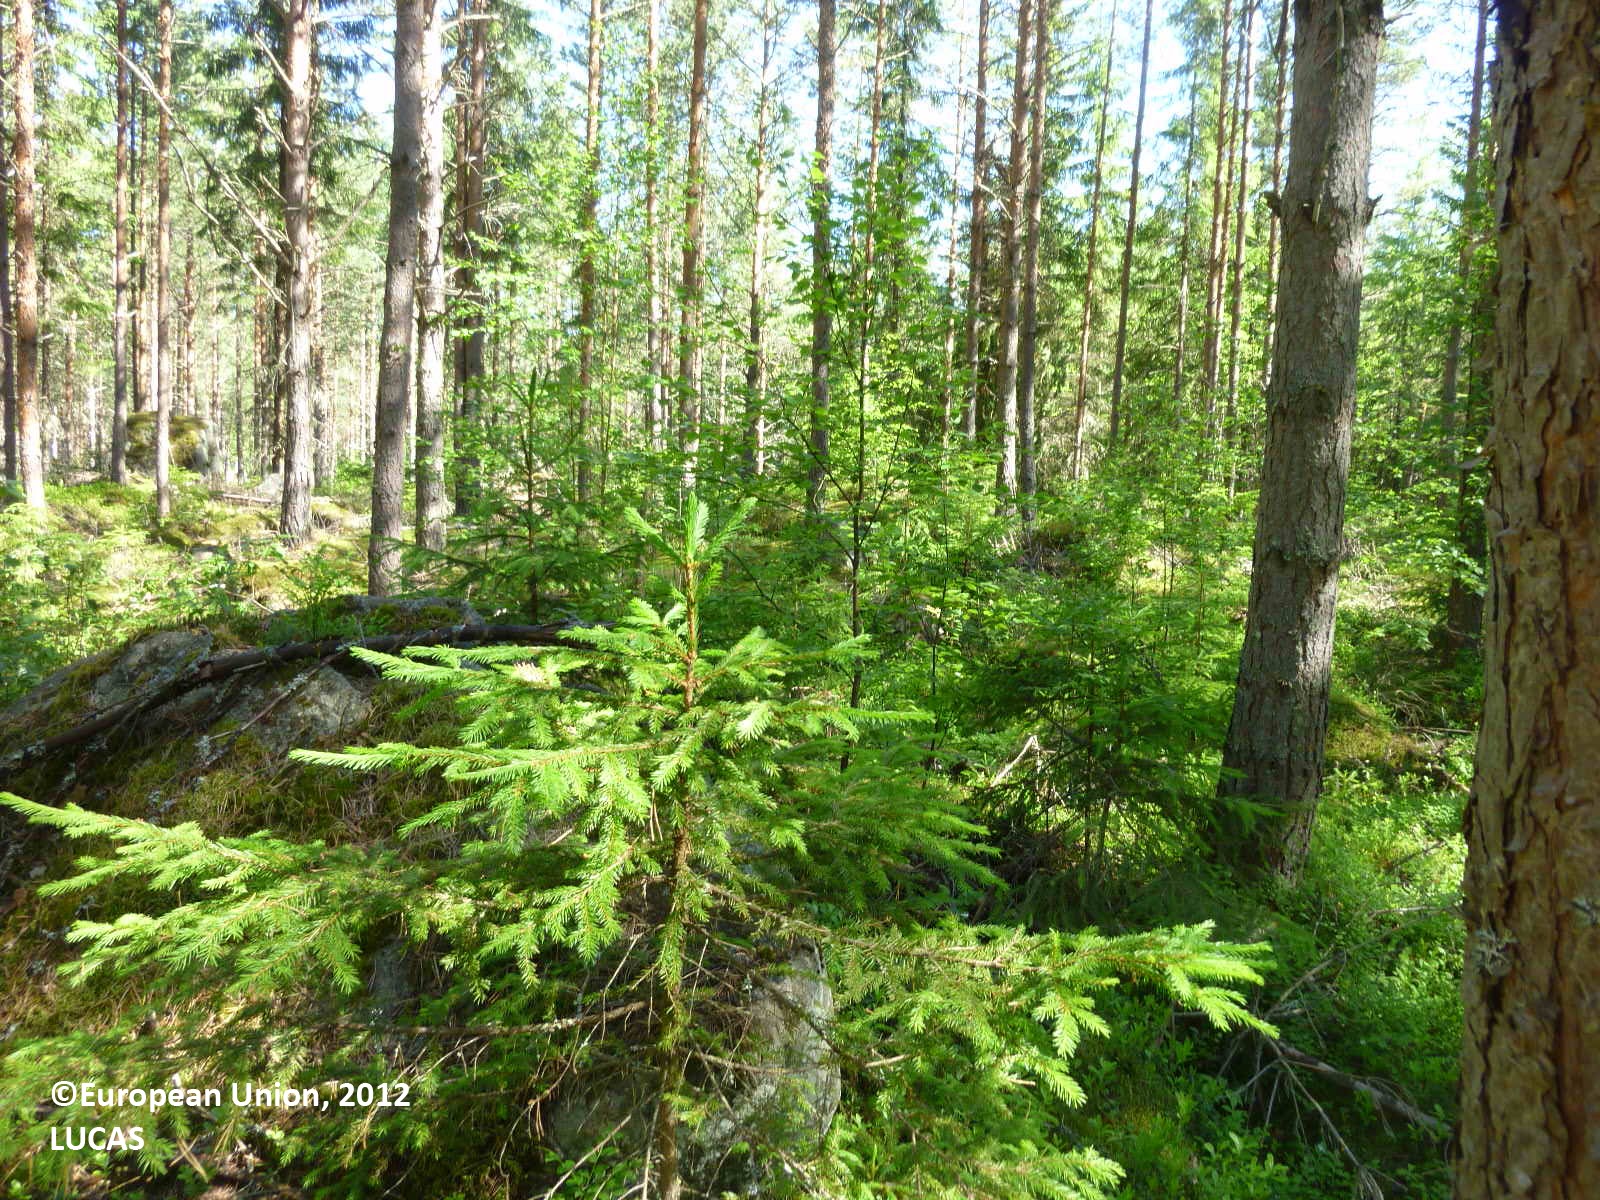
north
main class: Woodland
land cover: Pine dominated coniferous woodland
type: boreal forest
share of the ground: 50 - 75 %
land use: Forestry
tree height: > 5 m
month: June
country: FI
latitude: 61.6250
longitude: 22.1485
